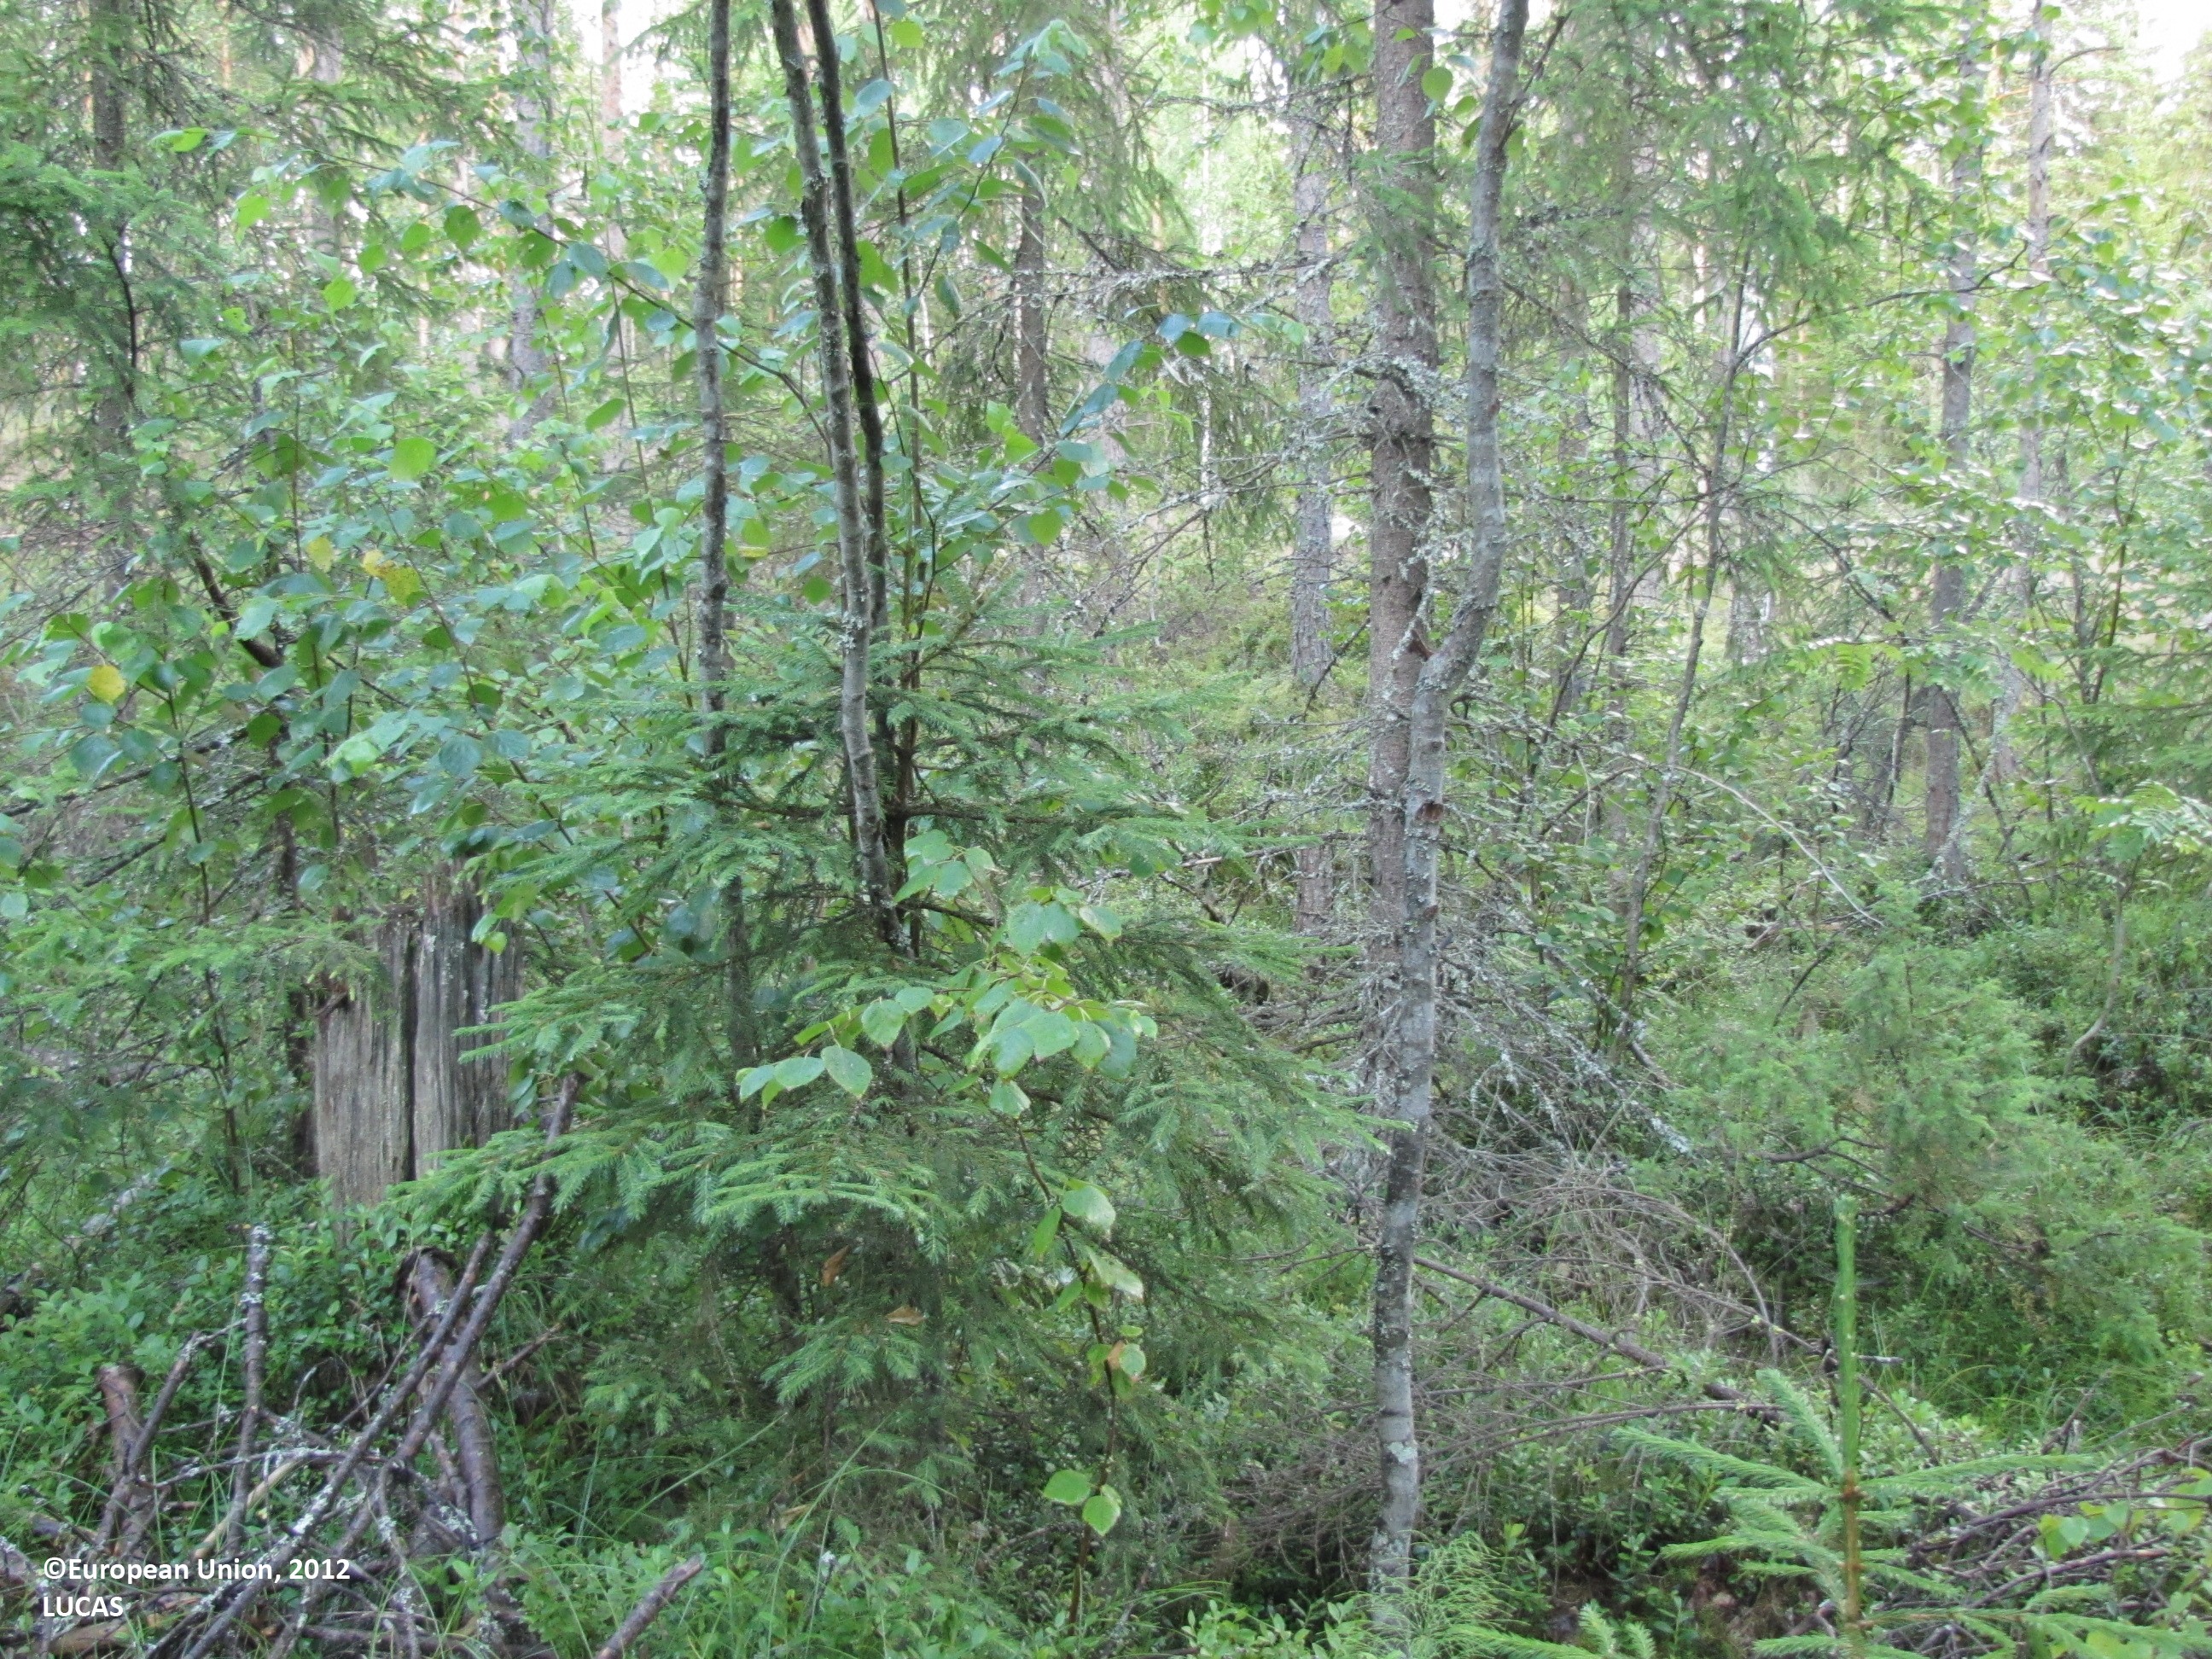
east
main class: Woodland
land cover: Pine dominated coniferous woodland
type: boreal forest
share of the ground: 25 - 50 %
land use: Forestry
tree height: > 5 m
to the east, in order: Pine dominated coniferous woodland; Ditches and canals; Grass margins; Tracks; Grass margins; Ditches and canals; Pine dominated mixed woodland; Pine dominated coniferous woodland
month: July
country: FI
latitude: 62.0447
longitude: 23.0124
